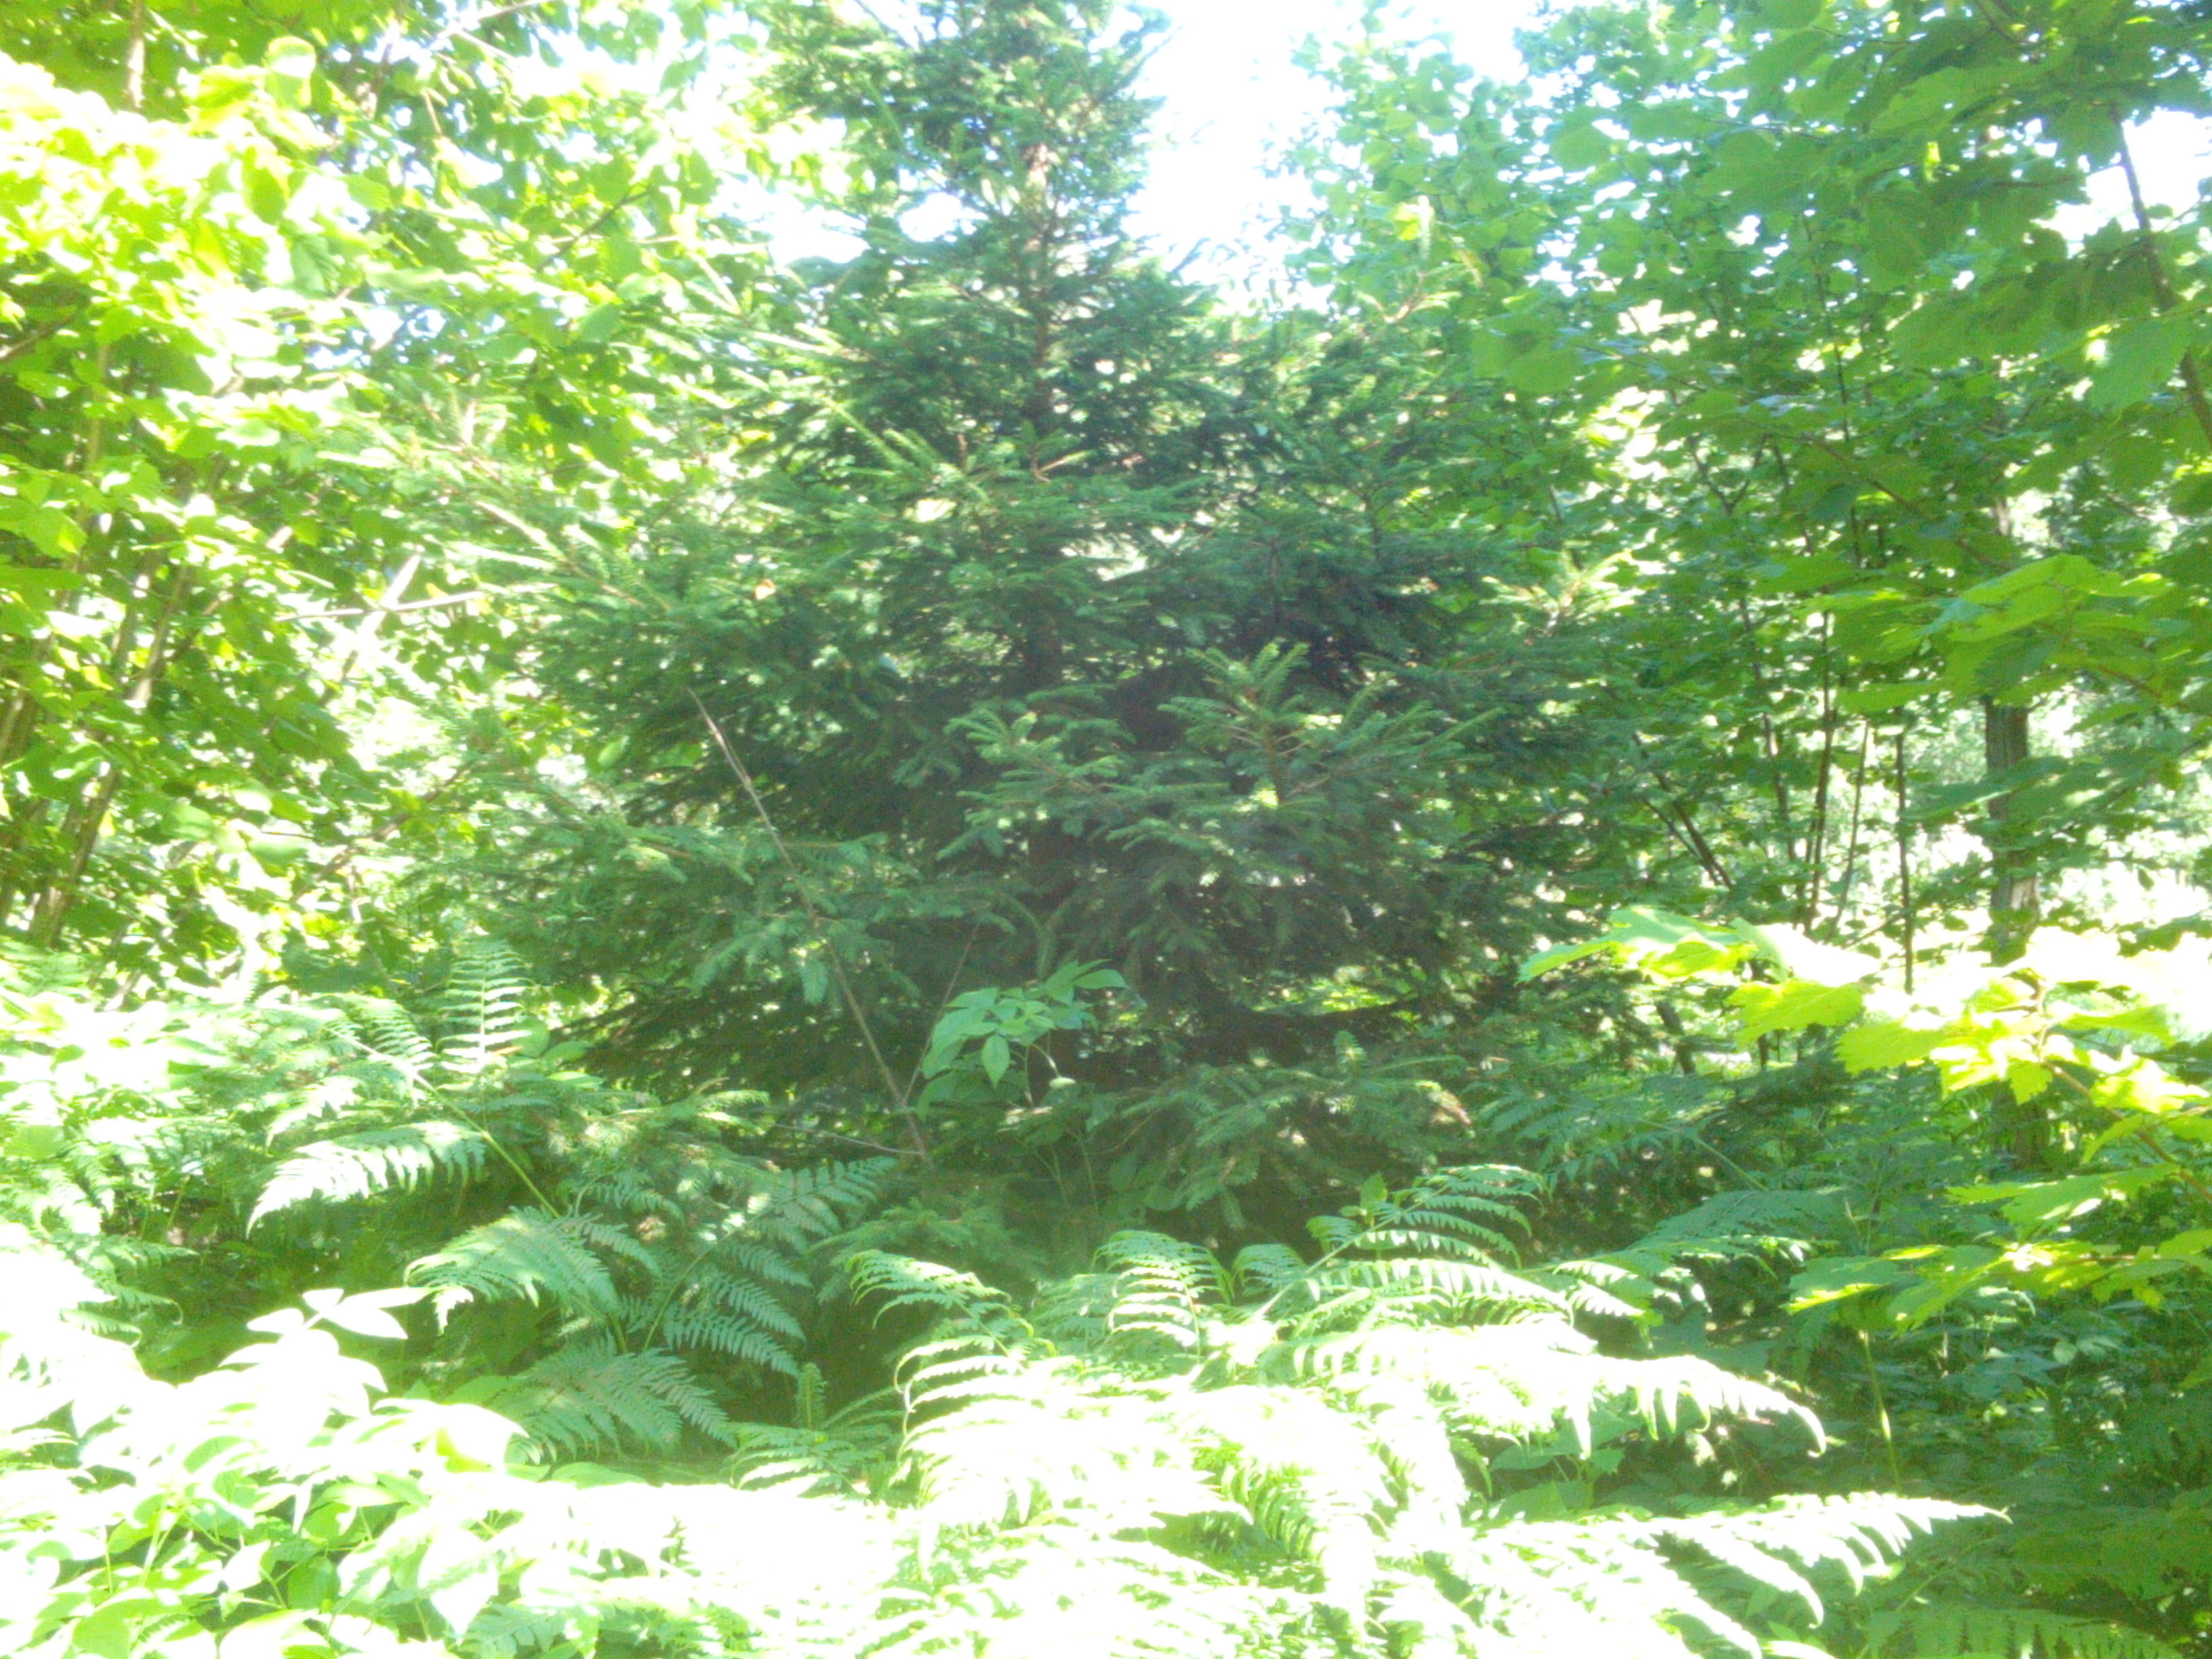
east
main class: Woodland
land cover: Spruce dominated mixed woodland
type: hemiboreal forest and nemoral coniferous forest and mixed broadleaved-coniferous forest
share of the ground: 50 - 75 %
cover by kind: broadleaved forest trees 45 %, coniferous forest trees 25 %, herbaceous plants 25 %, shrubs 5 %
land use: Forestry
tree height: > 5 m
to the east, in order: Spruce dominated mixed woodland; Spontaneously vegetated surfaces; Electric lines; Grassland with sparse tree/shrub cover; Ditches and canals; Shruby margins; Paved roads, cycling and walking lanes; Grass margins; Broadleaved woodland
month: August
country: LV
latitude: 56.9393
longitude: 21.9297
